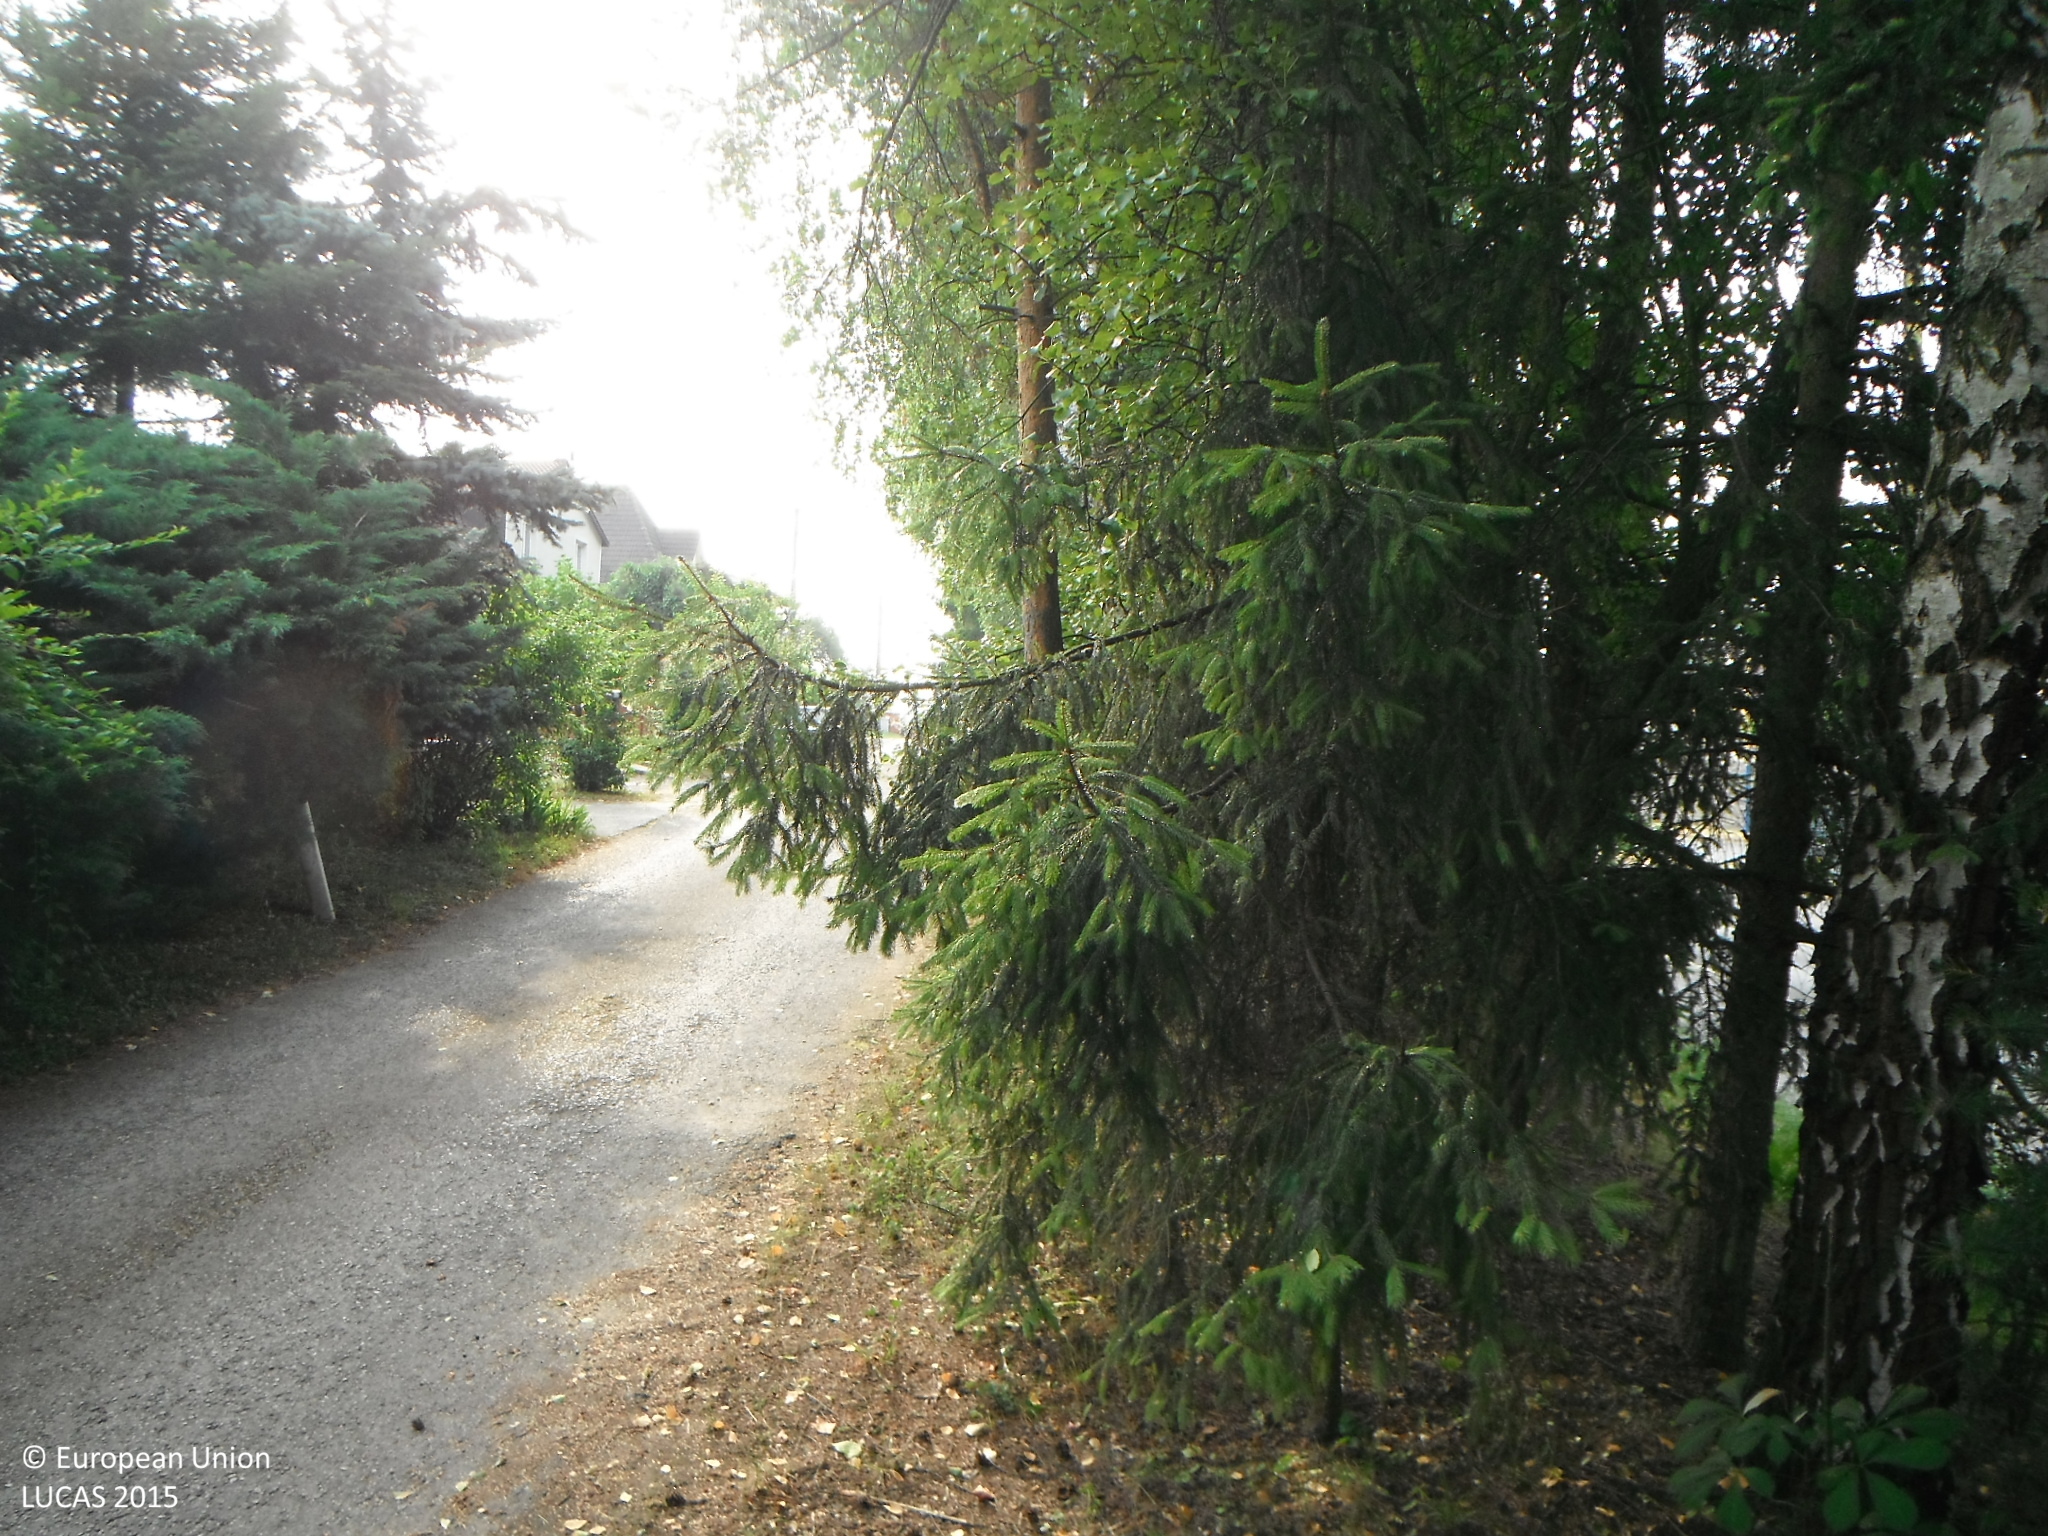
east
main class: Woodland
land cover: Other mixed woodland
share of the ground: > 75 %
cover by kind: coniferous forest trees 50 %, broadleaved forest trees 50 %
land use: Residential
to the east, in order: Other mixed woodland; Artificial constructions in urban areas
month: July
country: SK
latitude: 48.5695
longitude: 19.1152
